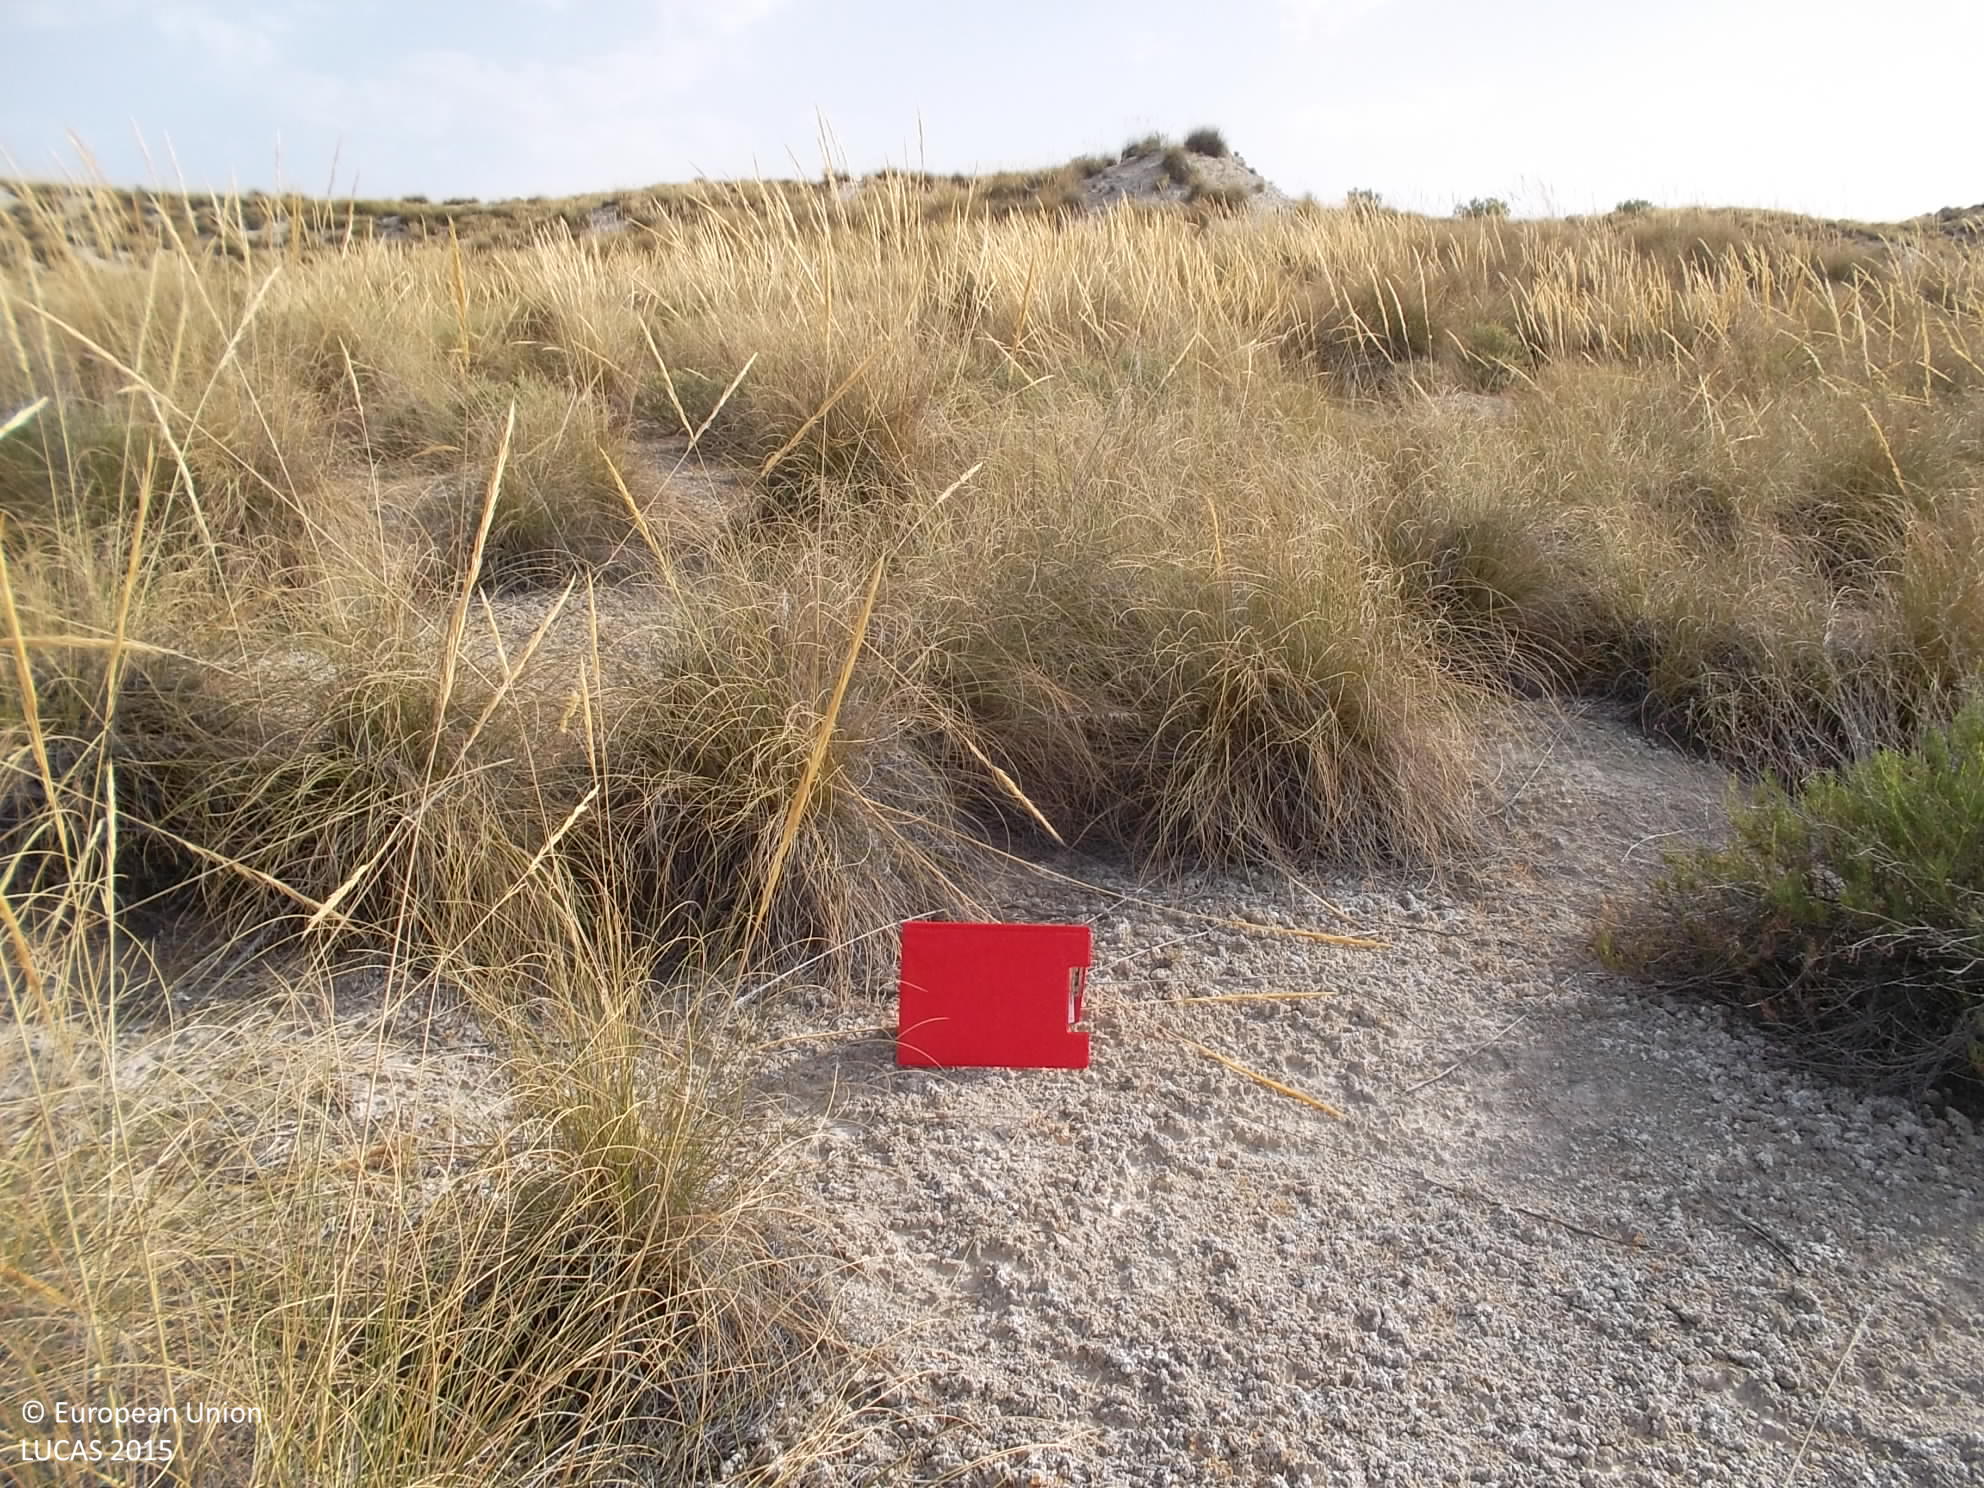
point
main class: Shrubland
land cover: Shrubland without tree cover
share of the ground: 50 - 75 %
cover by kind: shrubs 60 %, herbaceous plants 20 %, consolidated bare surface 20 %
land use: Semi-natural and natural areas not in use
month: July
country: ES
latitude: 37.6358
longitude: -2.7604
